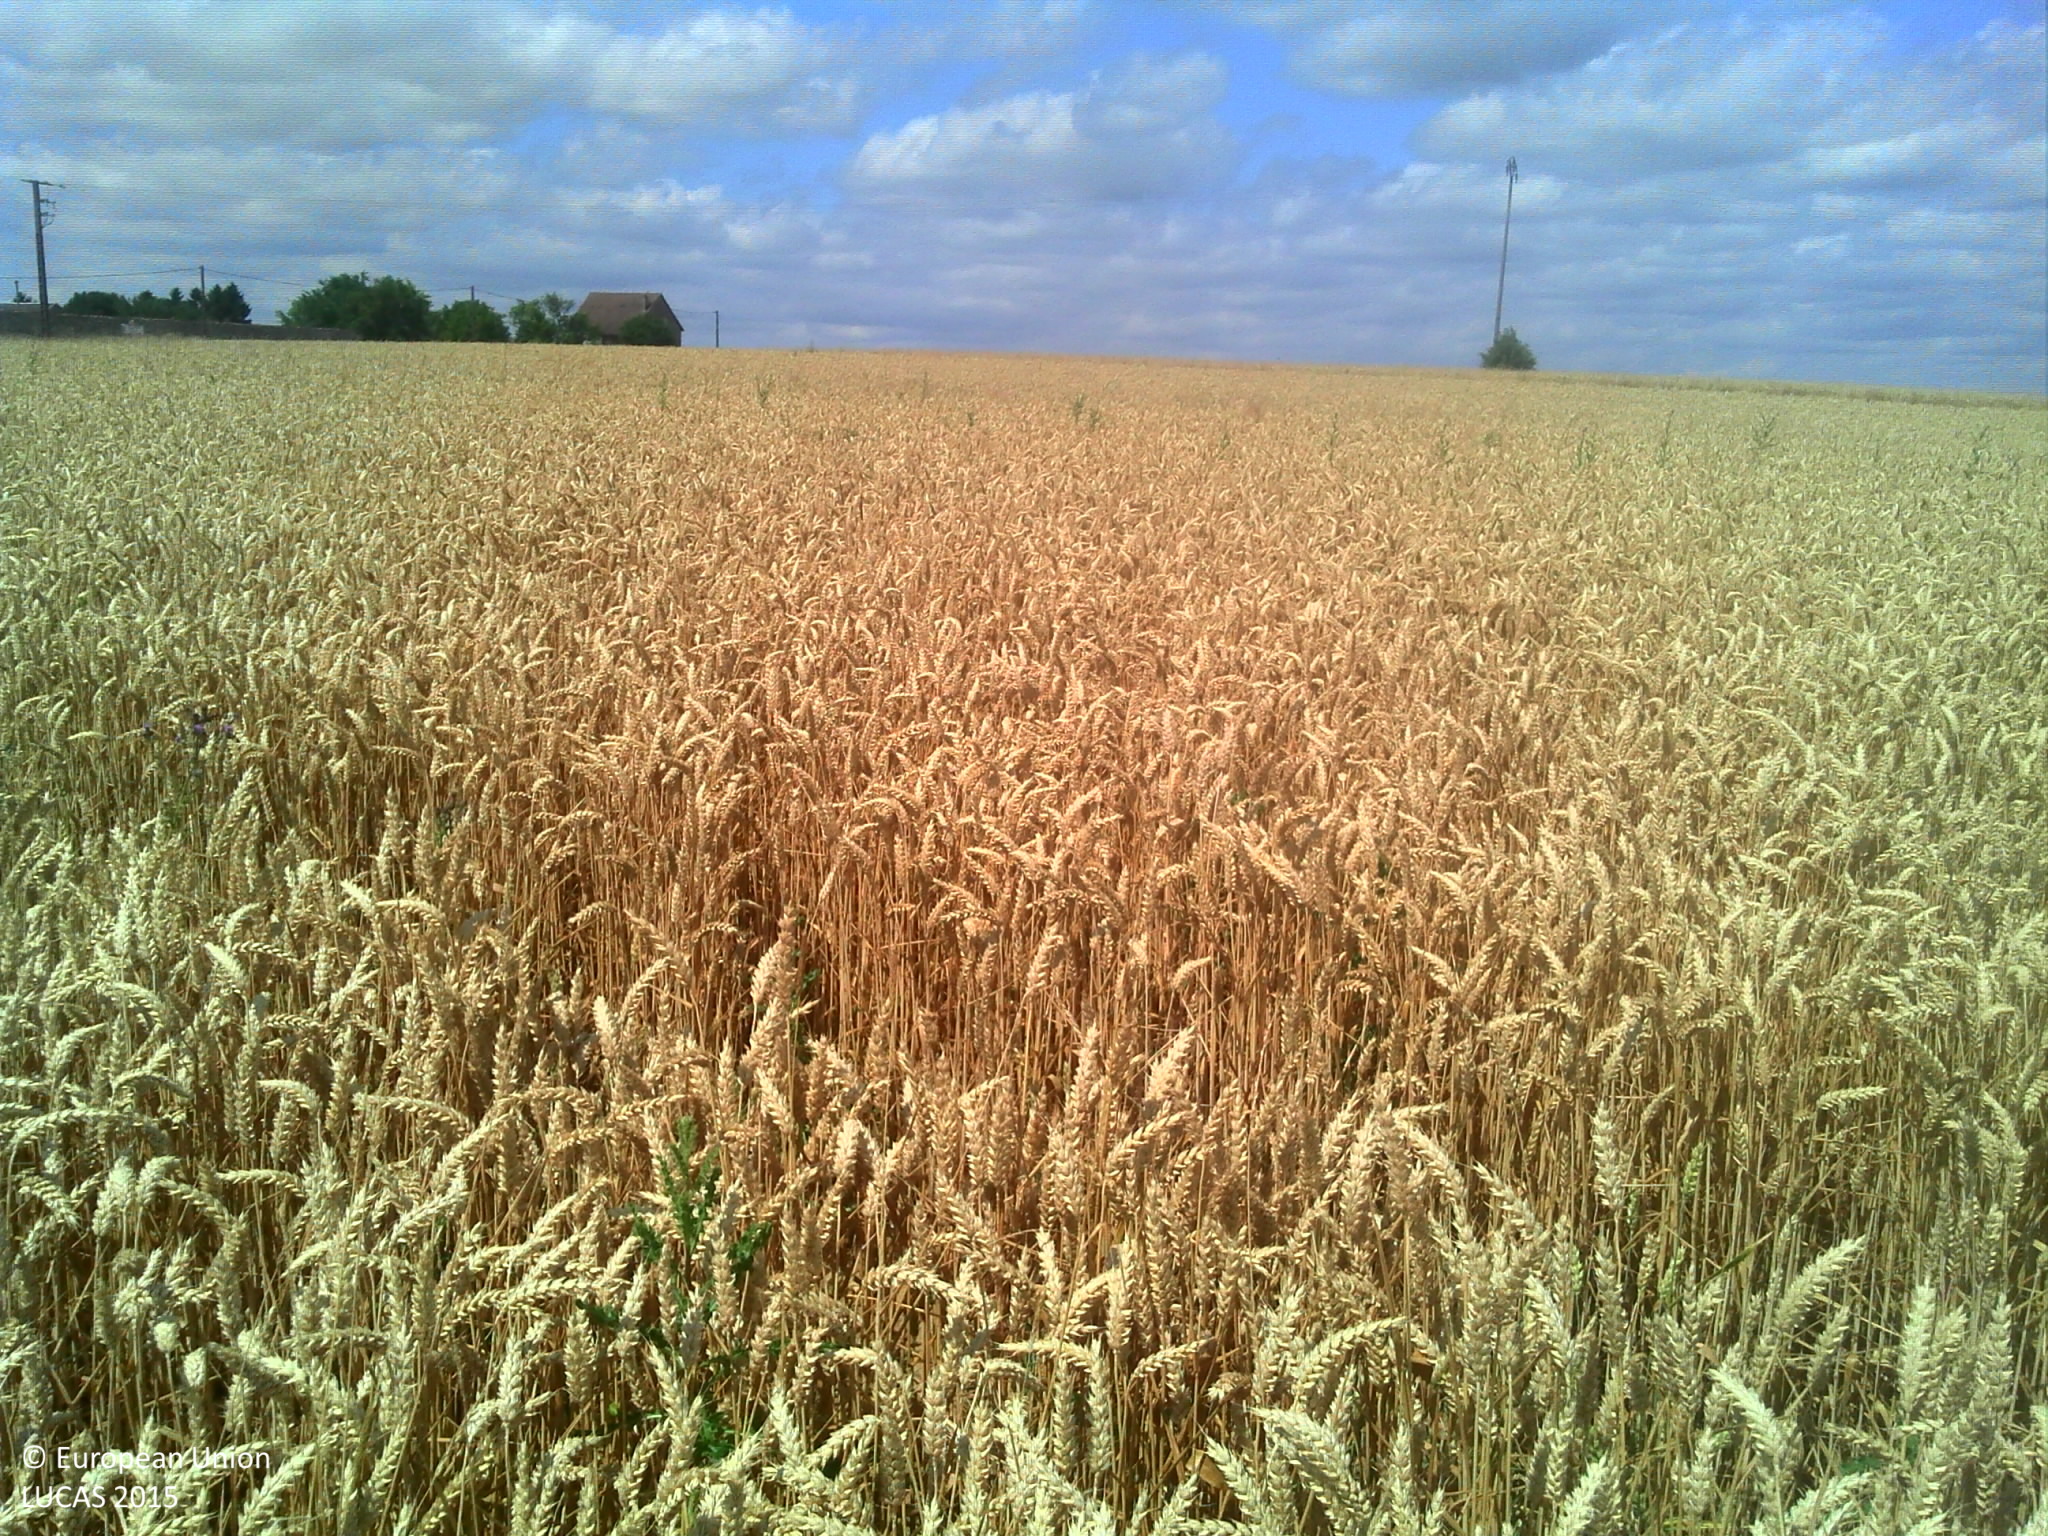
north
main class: Cropland
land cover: Common wheat
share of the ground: > 75 %
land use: Agriculture (excluding fallow land and kitchen gardens)
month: July
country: FR
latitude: 49.2473
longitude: 3.3022
